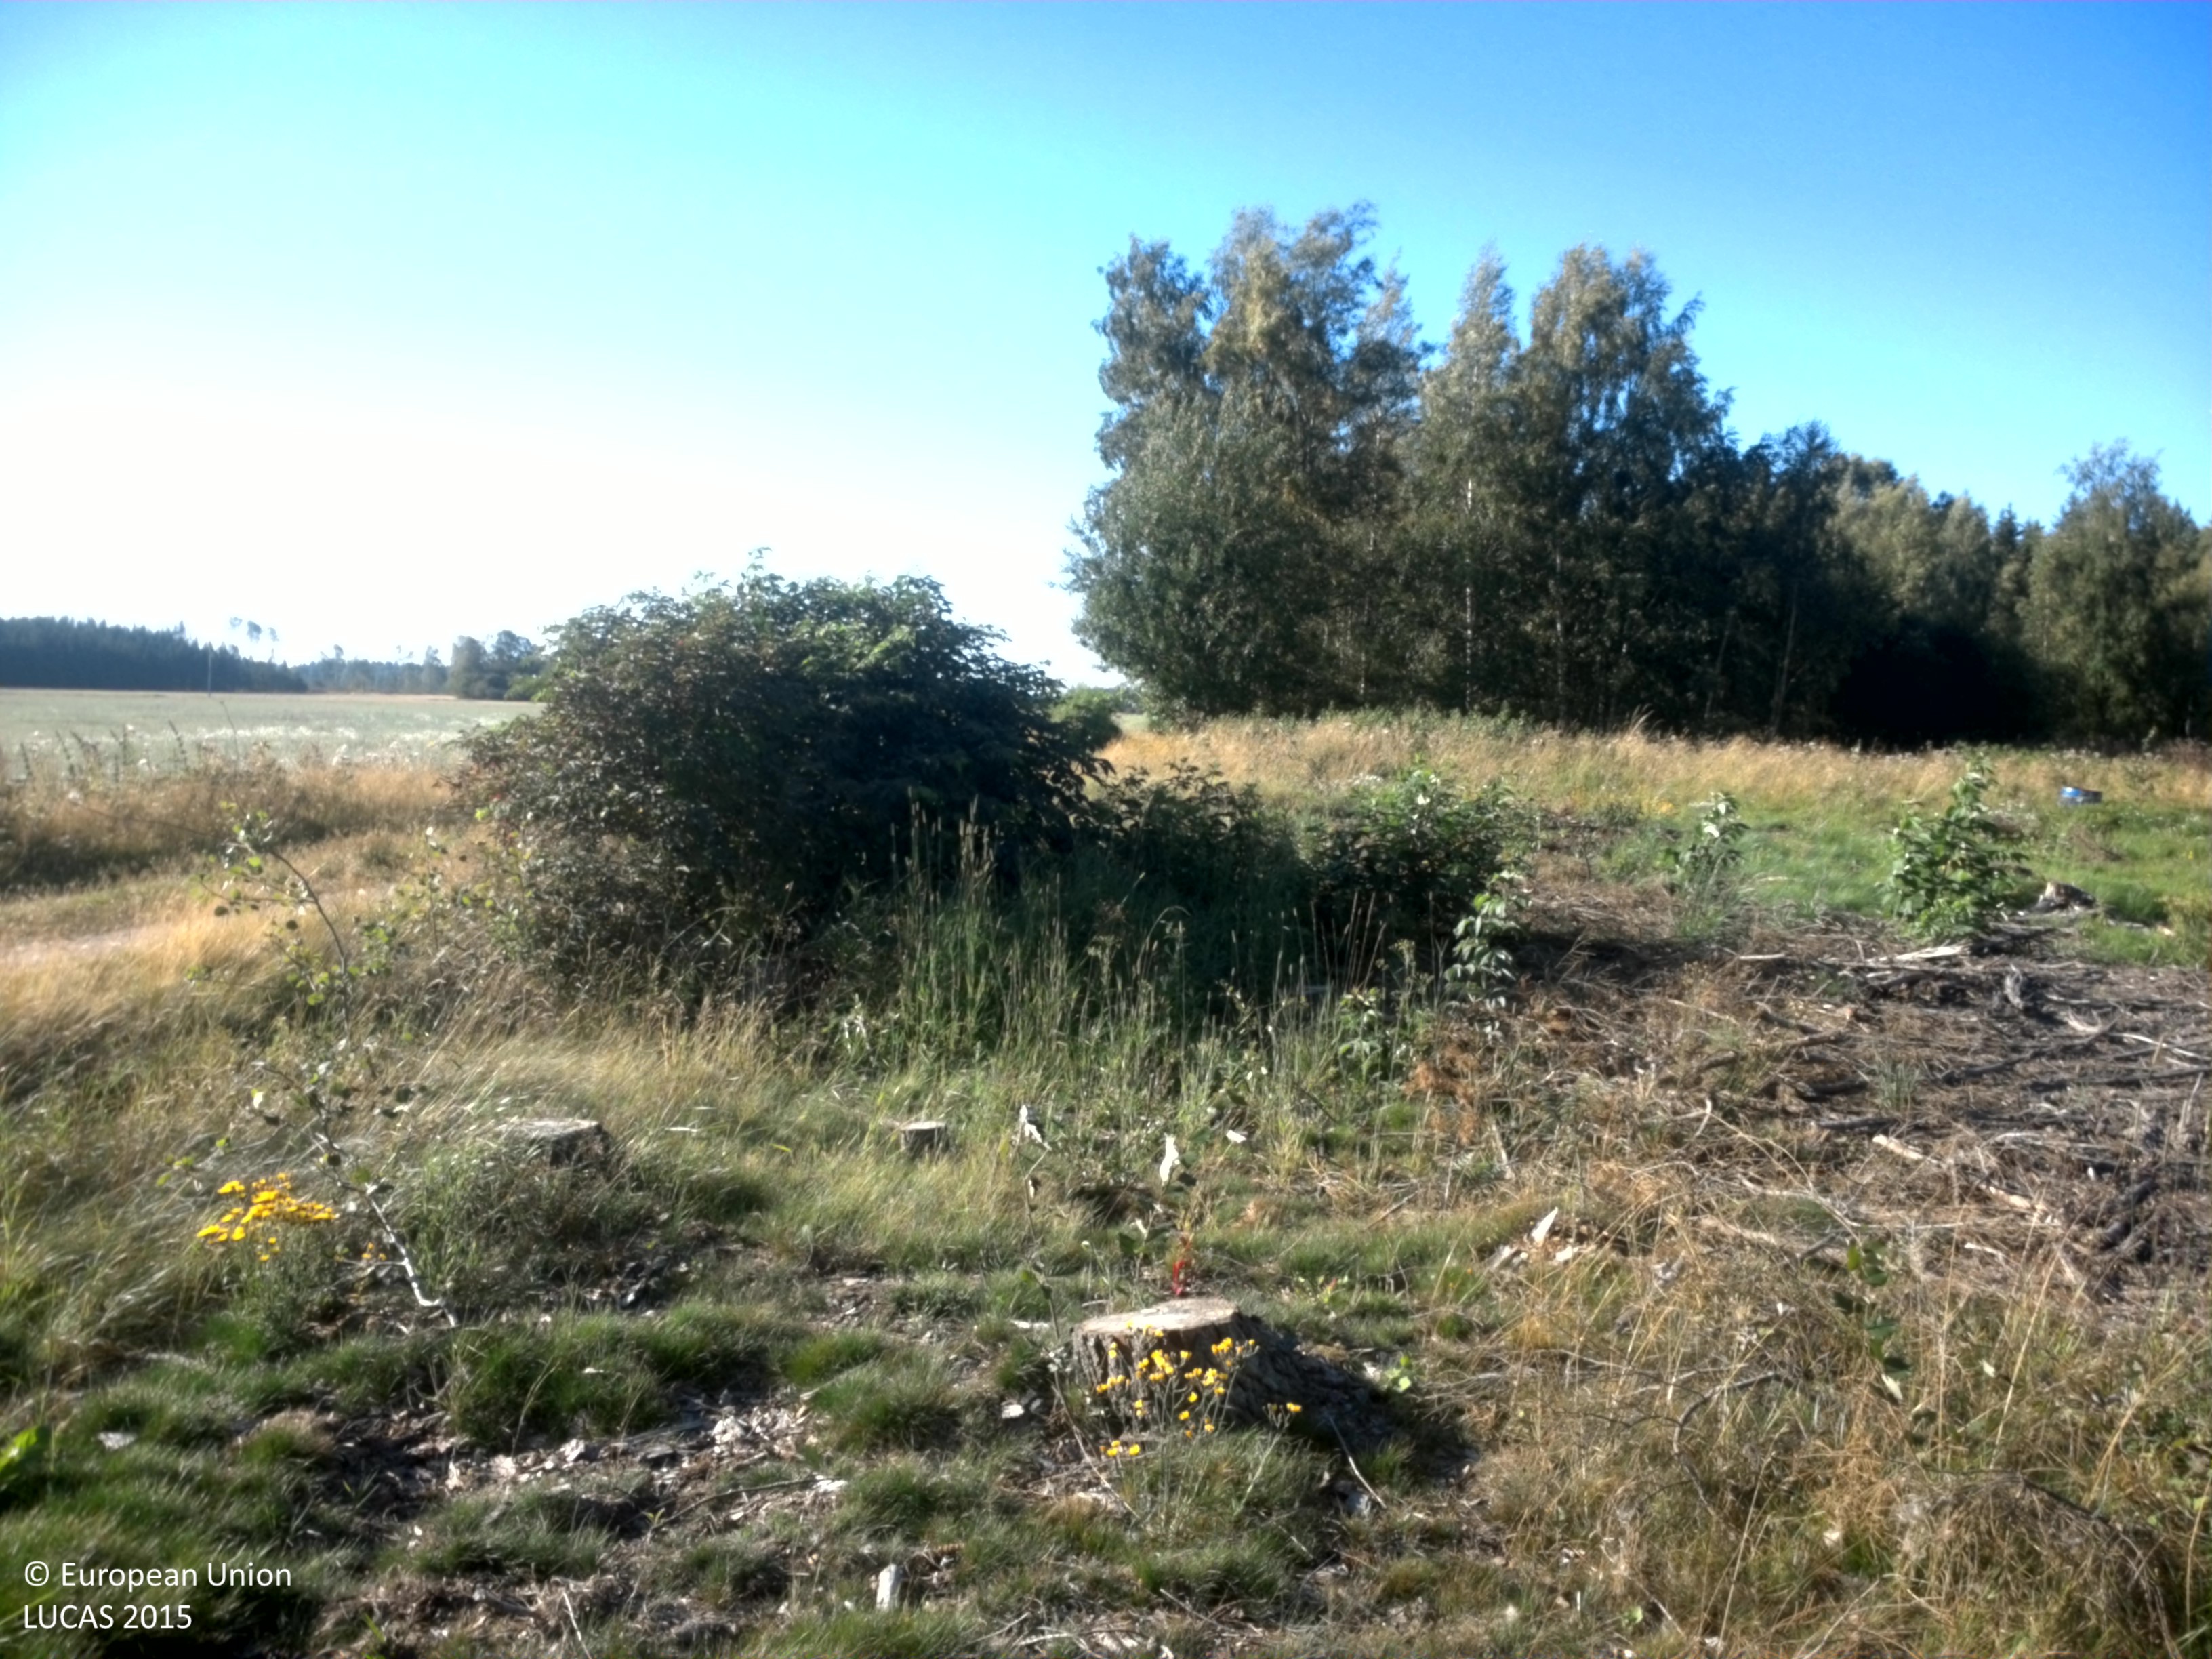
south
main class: Woodland
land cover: Broadleaved woodland
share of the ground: < 10 %
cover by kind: consolidated bare surface 85 %, broadleaved forest trees 10 %, herbaceous plants 5 %
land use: Forestry
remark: Clear cut
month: August
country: SE
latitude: 58.3429
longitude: 13.2231
